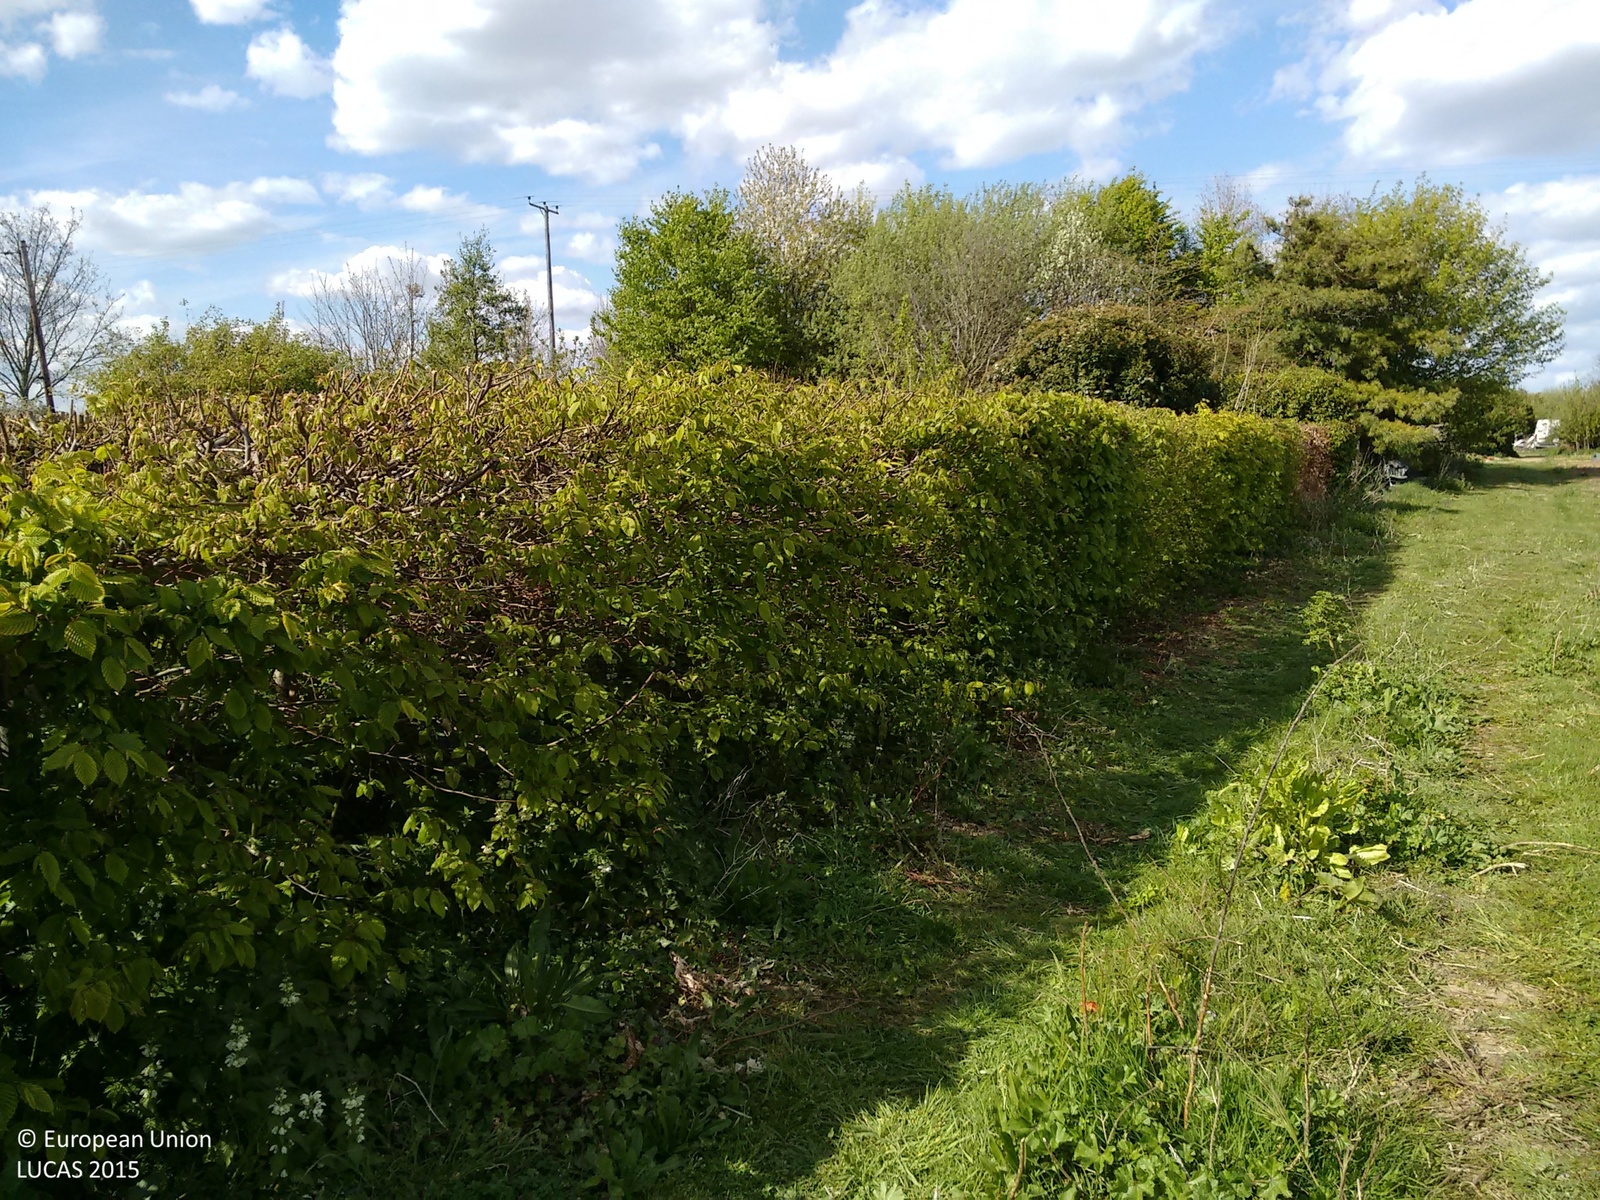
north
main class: Grassland
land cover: Grassland without tree/shrub cover
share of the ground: > 75 %
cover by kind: herbaceous plants 100 %
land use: Residential
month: April
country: GB
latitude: 51.3541
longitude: 0.6252
